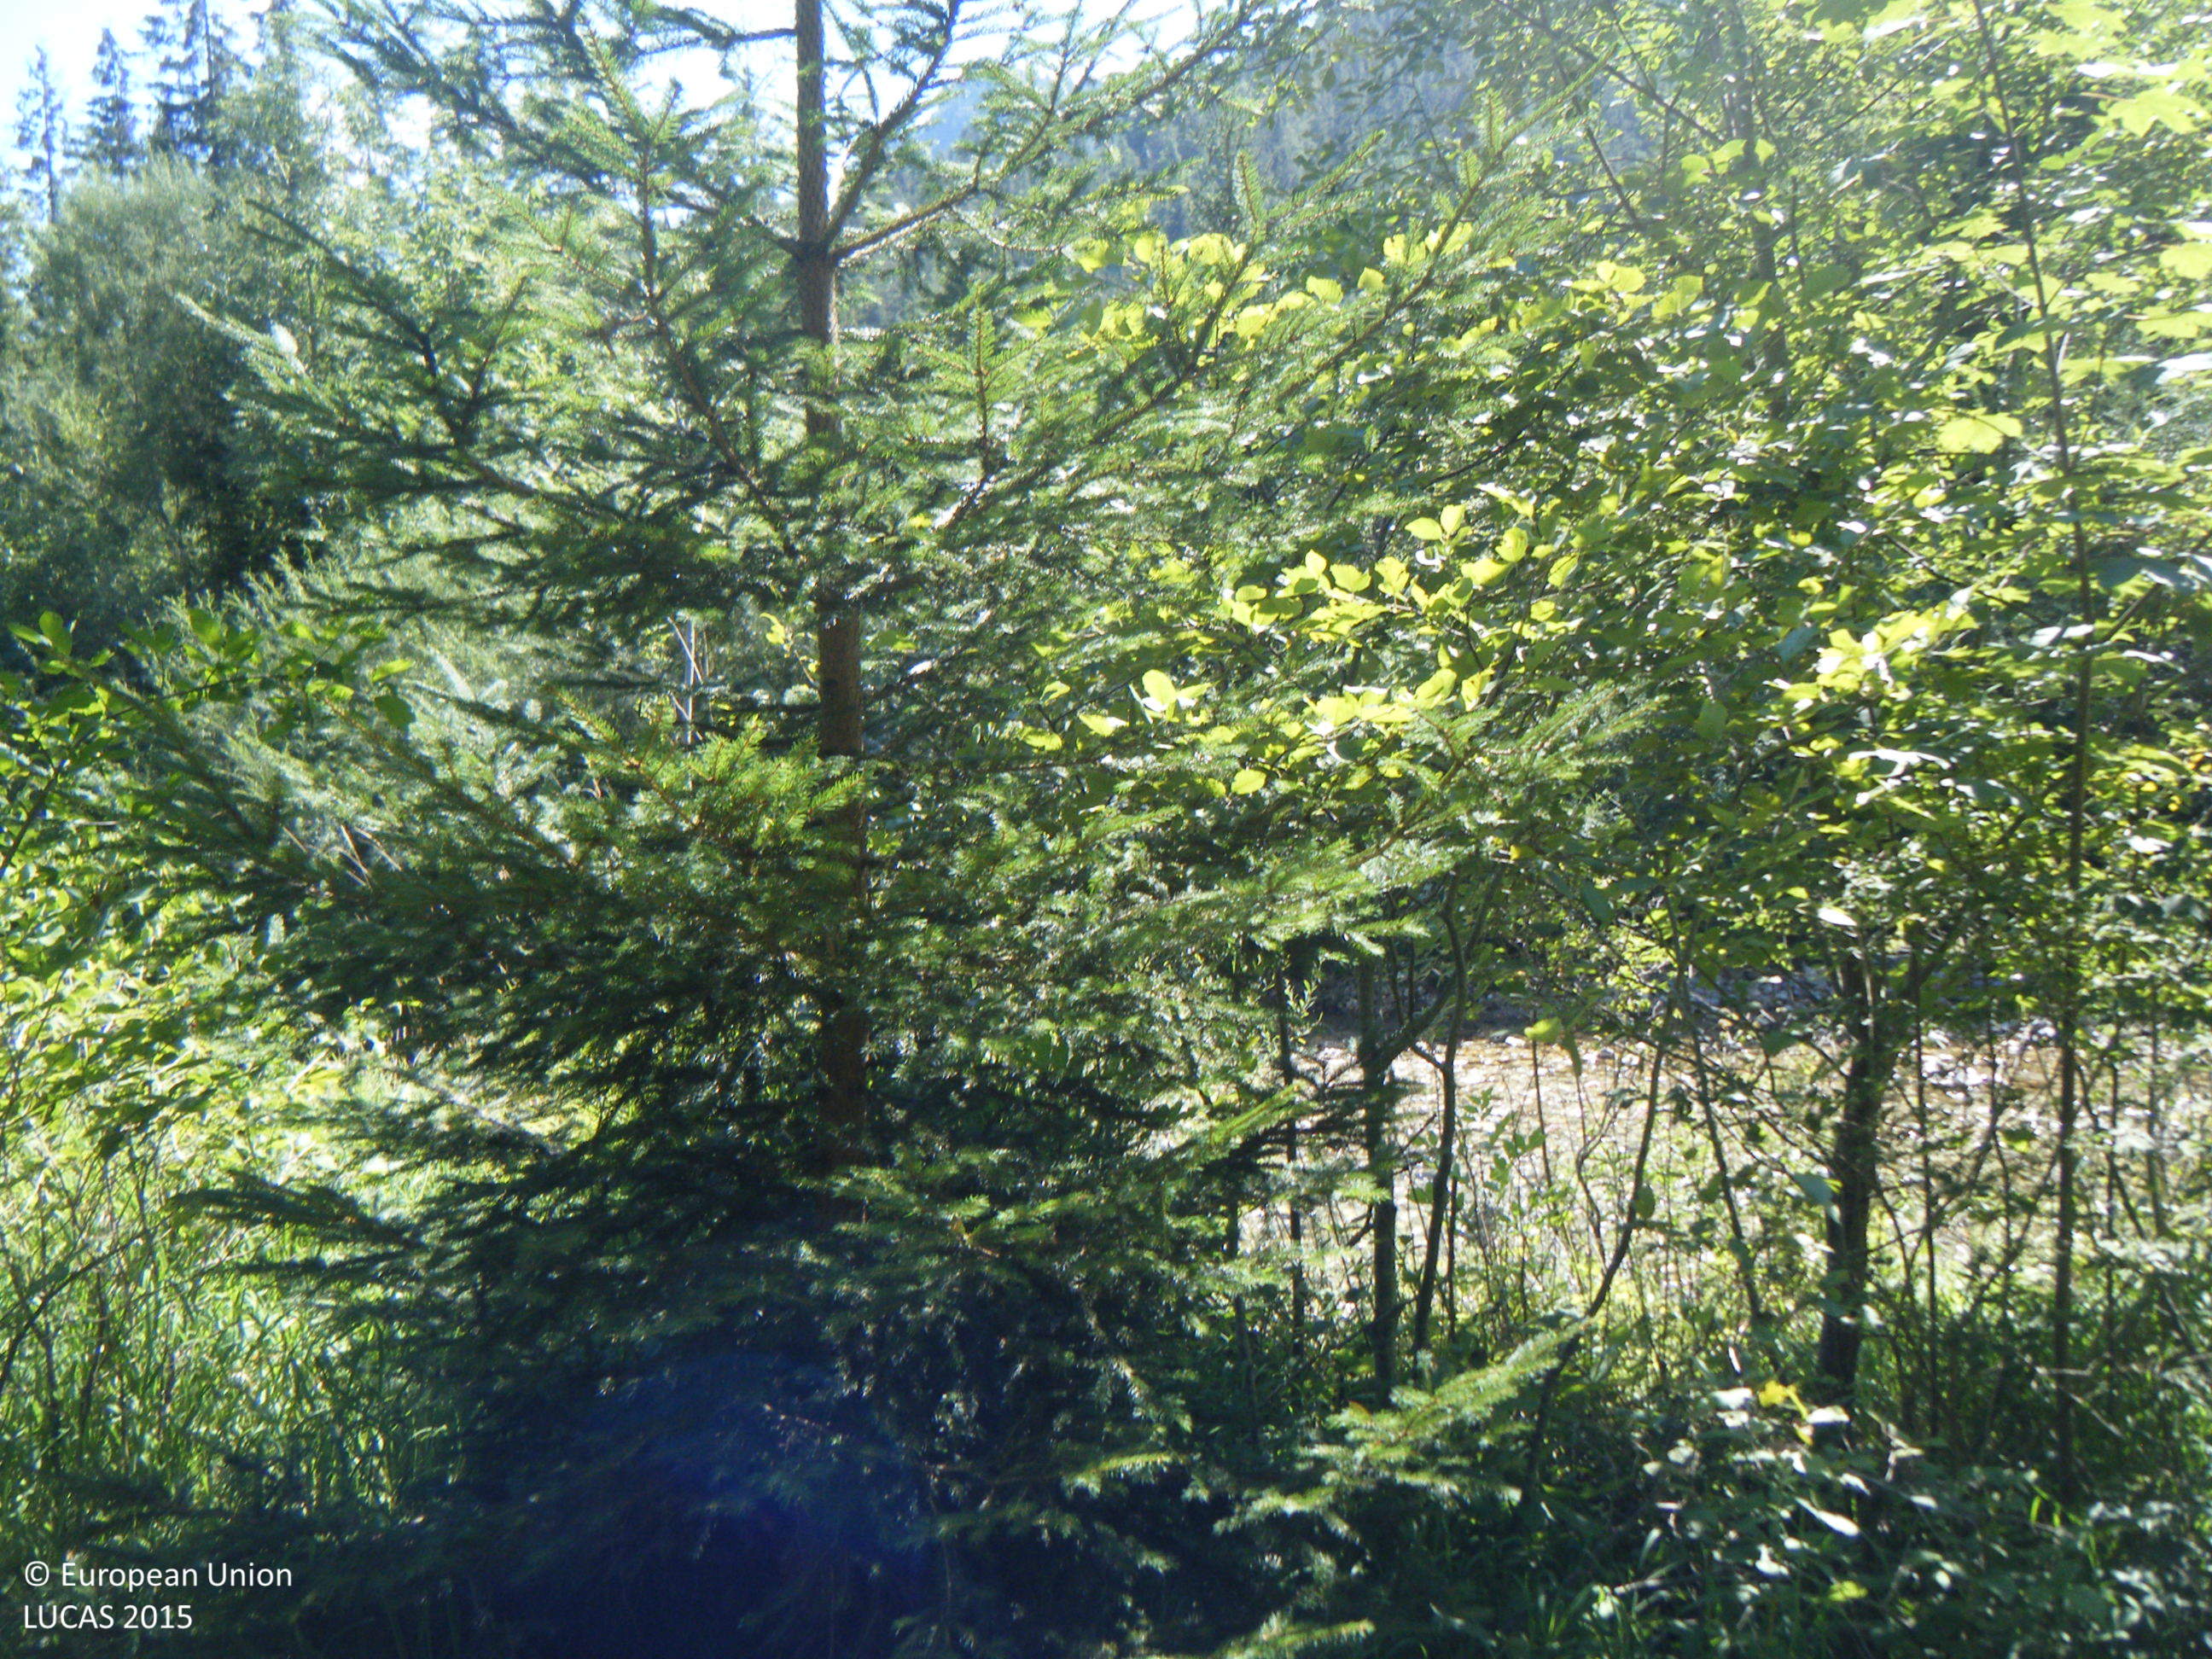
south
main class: Woodland
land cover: Broadleaved woodland
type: floodplain forest
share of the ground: > 75 %
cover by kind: broadleaved forest trees 70 %, coniferous forest trees 20 %, shrubs 5 %, herbaceous plants 5 %
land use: Forestry
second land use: Amenities, museums, leisure
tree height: > 5 m
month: August
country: AT
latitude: 47.5365
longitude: 14.0505
